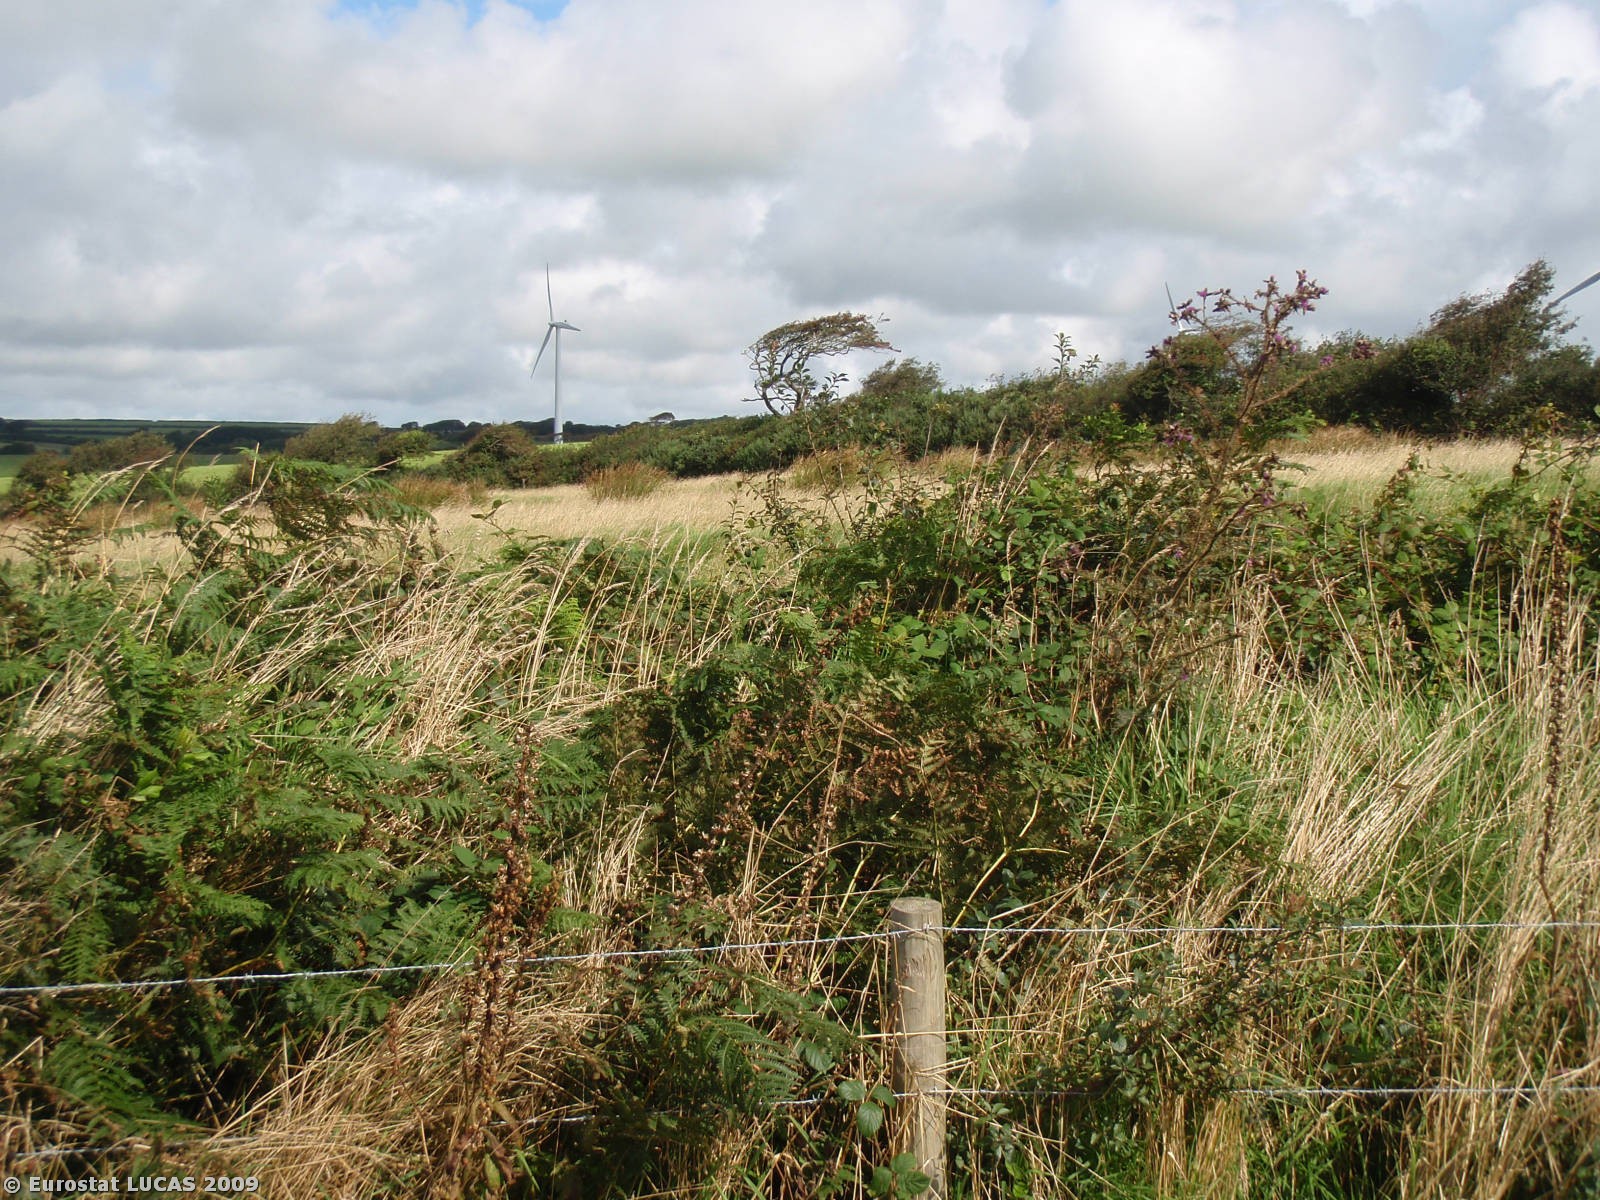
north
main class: Grassland
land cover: Grassland without tree/shrub cover
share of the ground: > 75 %
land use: Agriculture (excluding fallow land and kitchen gardens)
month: August
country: GB
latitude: 50.8879
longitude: -4.4180
